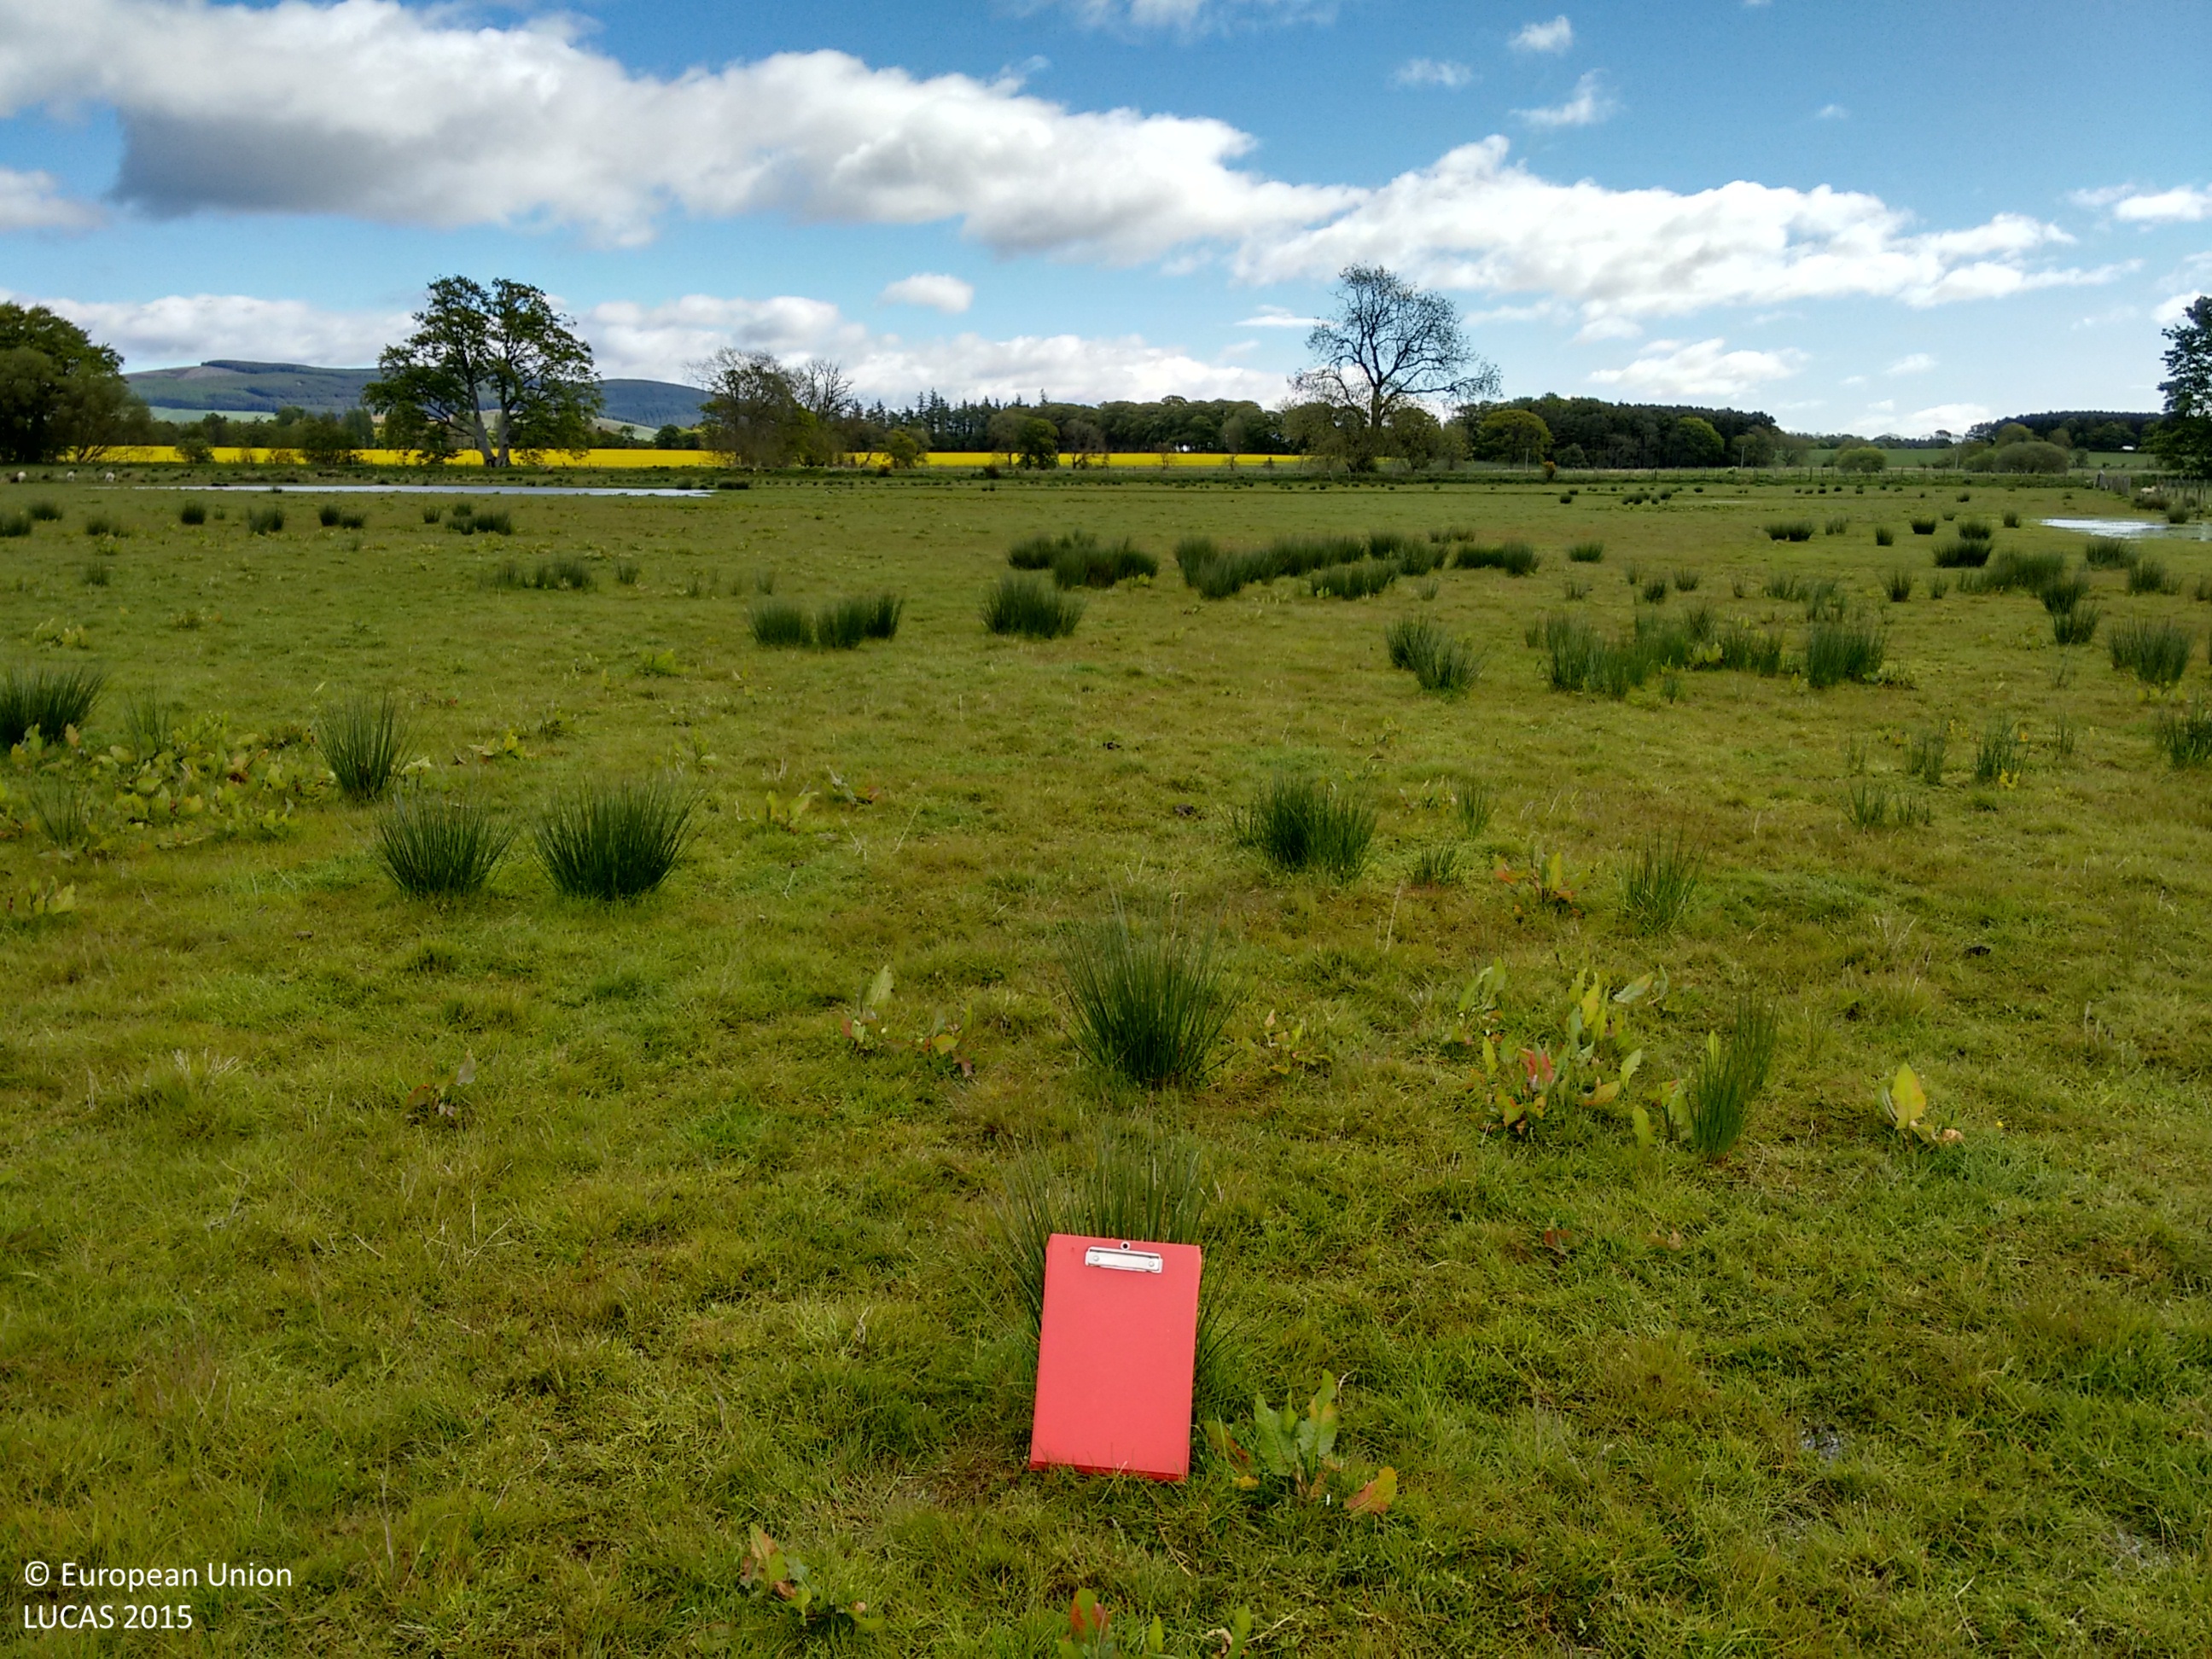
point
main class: Grassland
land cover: Grassland without tree/shrub cover
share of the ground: > 75 %
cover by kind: herbaceous plants 100 %
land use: Agriculture (excluding fallow land and kitchen gardens)
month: June
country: GB
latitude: 56.8428
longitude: -2.5652
